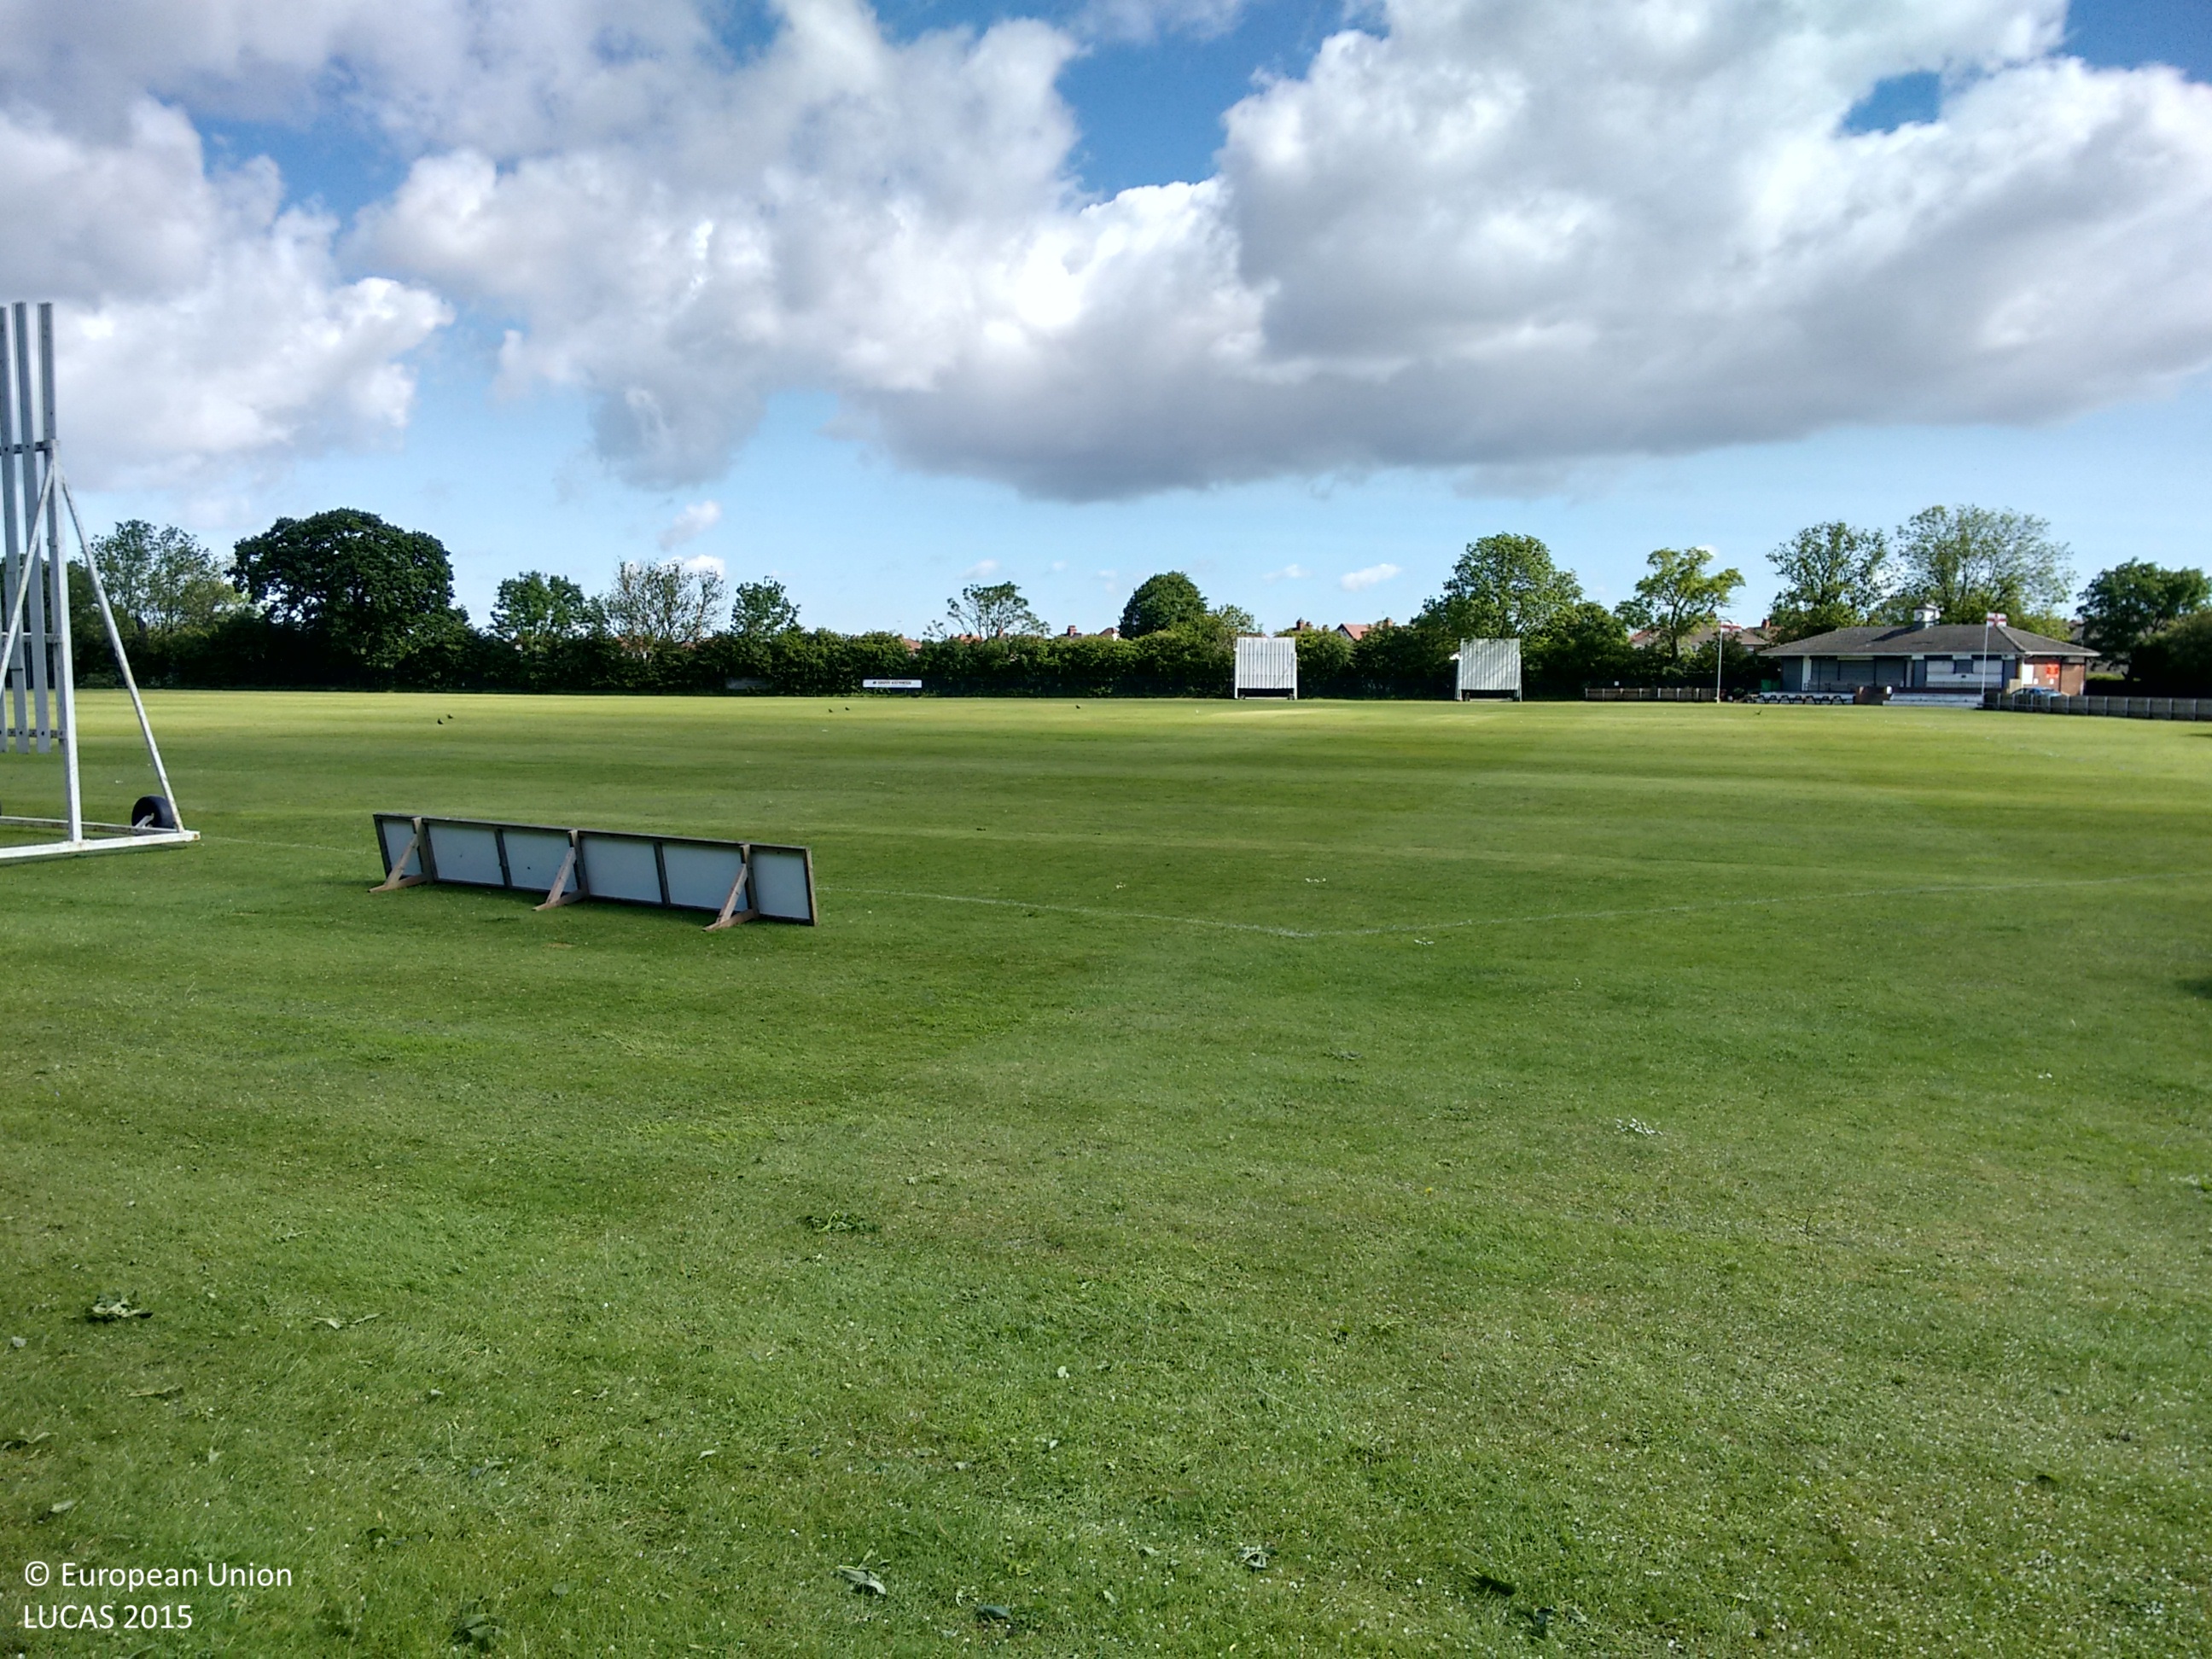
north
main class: Grassland
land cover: Grassland with sparse tree/shrub cover
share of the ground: > 75 %
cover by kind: herbaceous plants 85 %, shrubs 10 %, broadleaved forest trees 5 %
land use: Amenities, museums, leisure
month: June
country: GB
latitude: 53.5584
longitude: -0.1019
